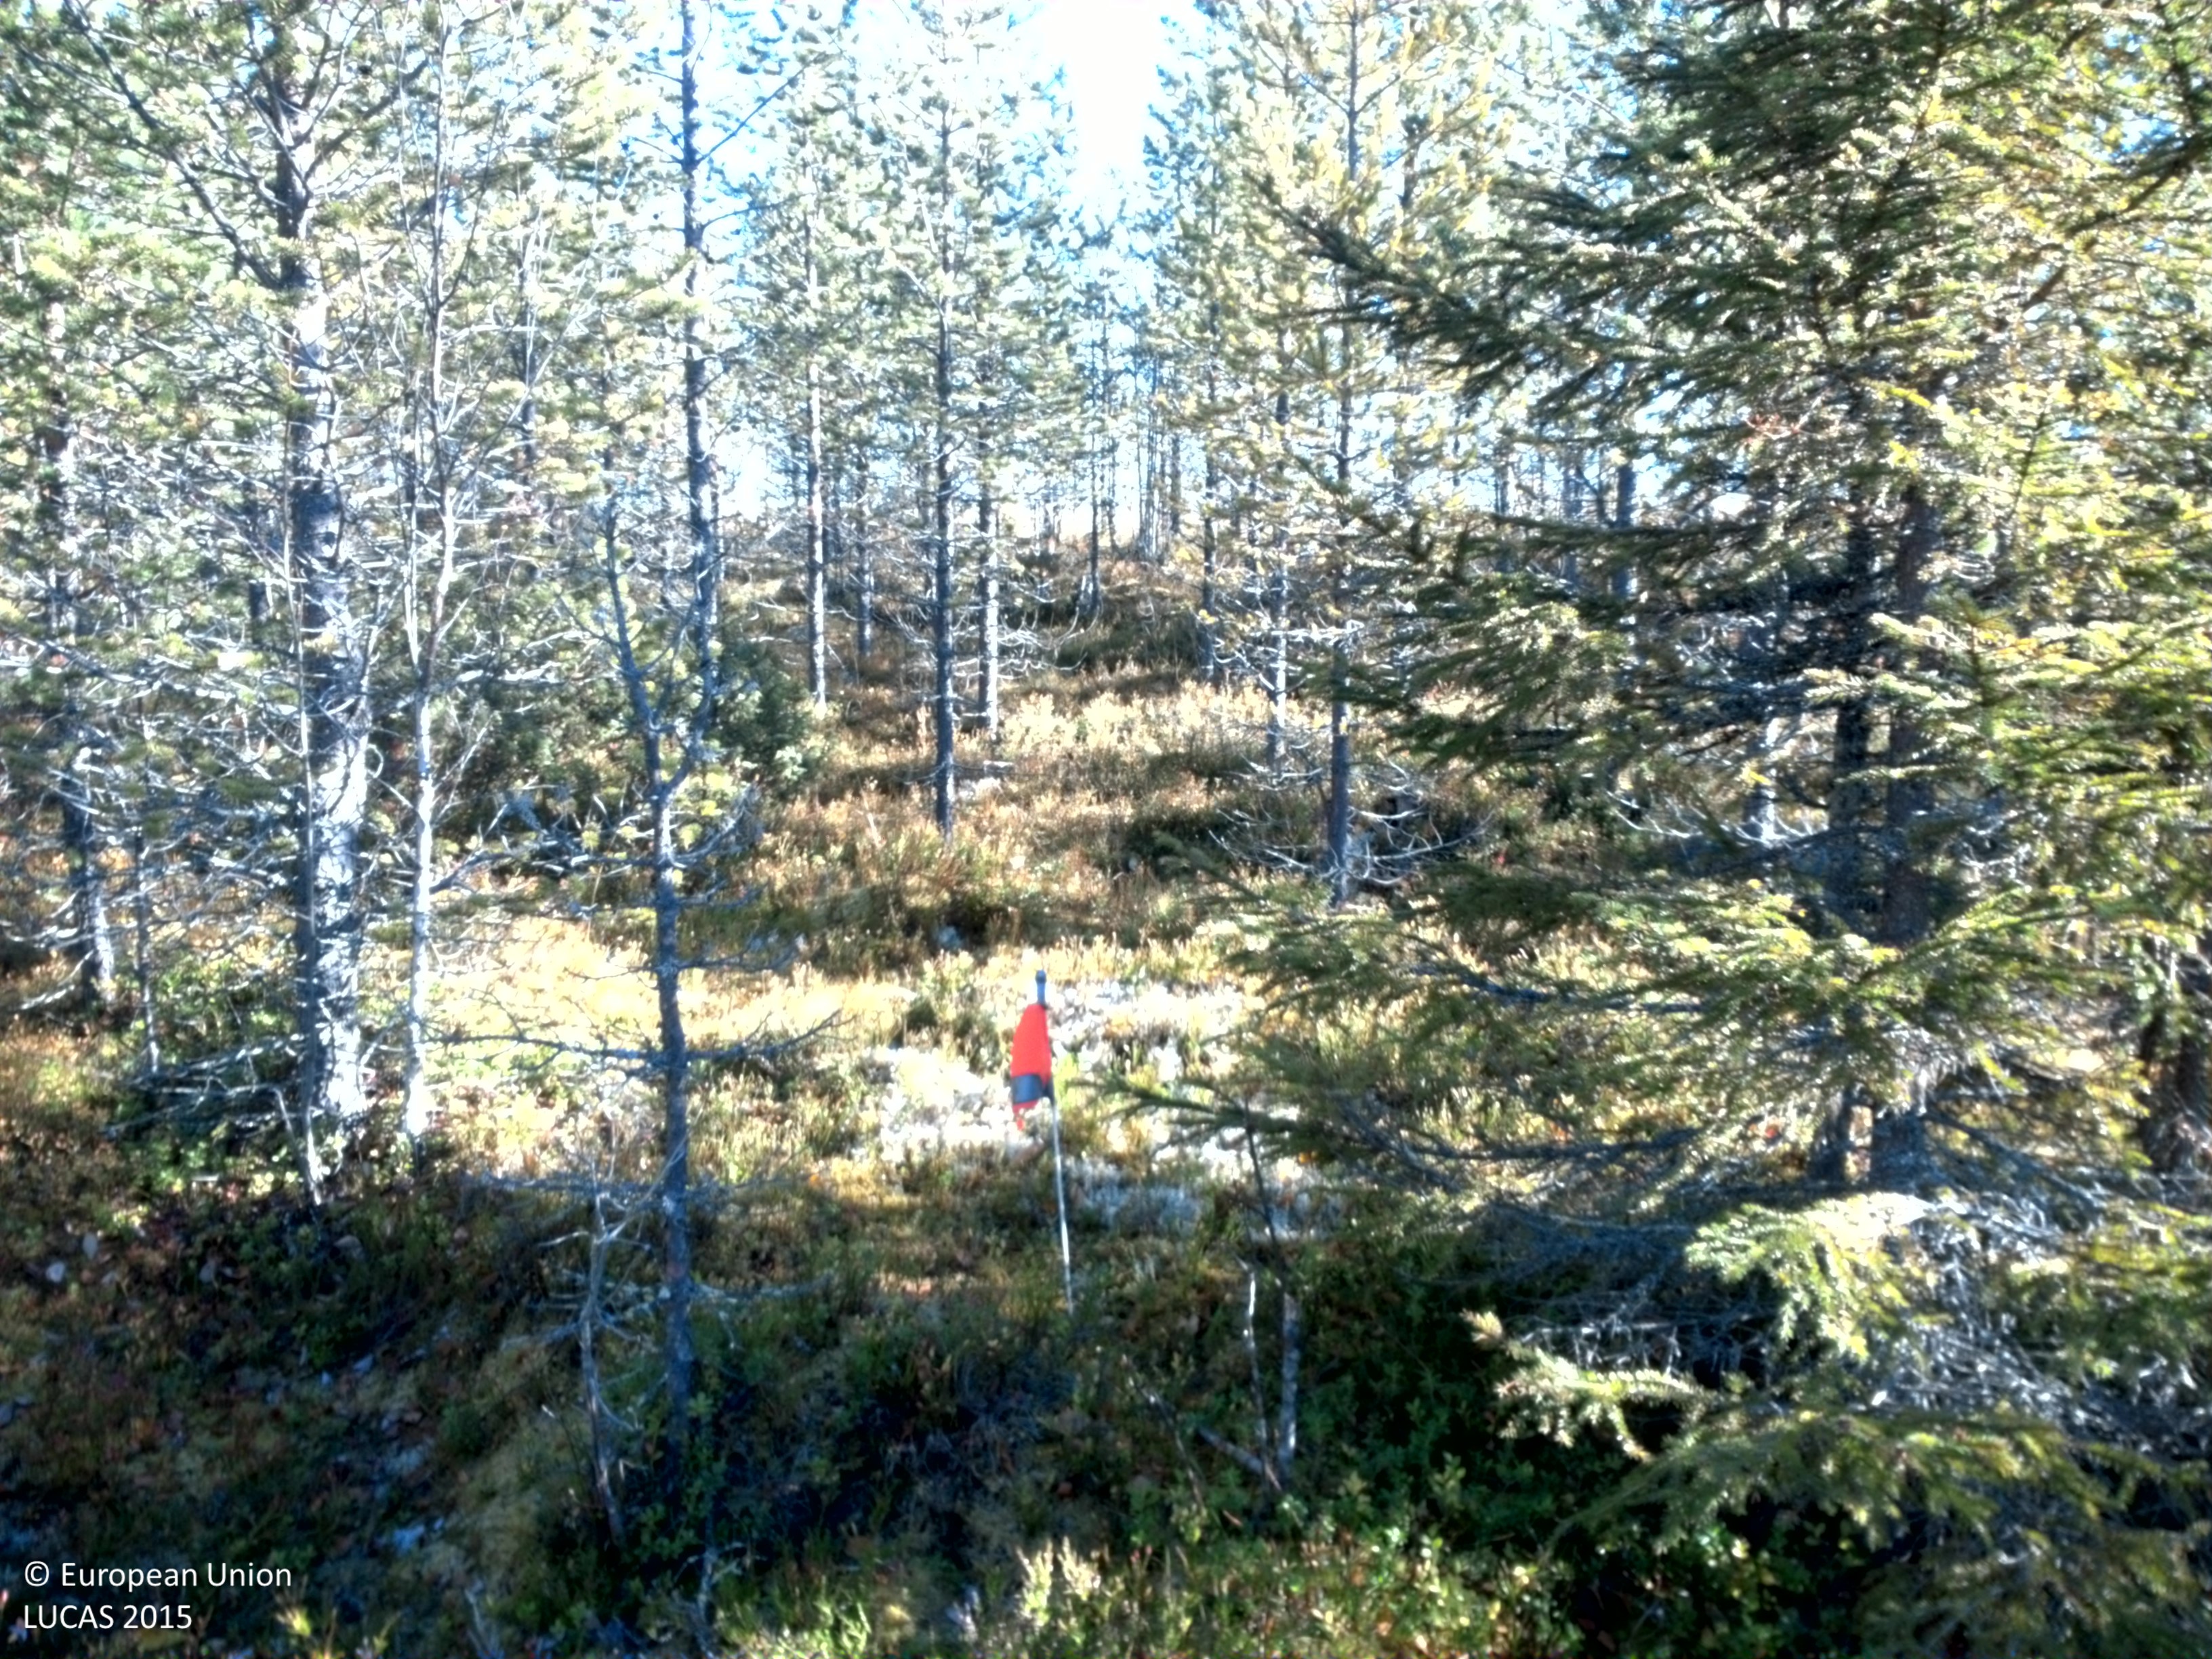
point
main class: Woodland
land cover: Pine dominated coniferous woodland
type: boreal forest
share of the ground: 50 - 75 %
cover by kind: coniferous forest trees 45 %, shrubs 30 %, lichens and mosses 15 %, broadleaved forest trees 5 %, herbaceous plants 5 %
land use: Forestry
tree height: > 5 m
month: October
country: SE
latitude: 64.8244
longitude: 17.4020
